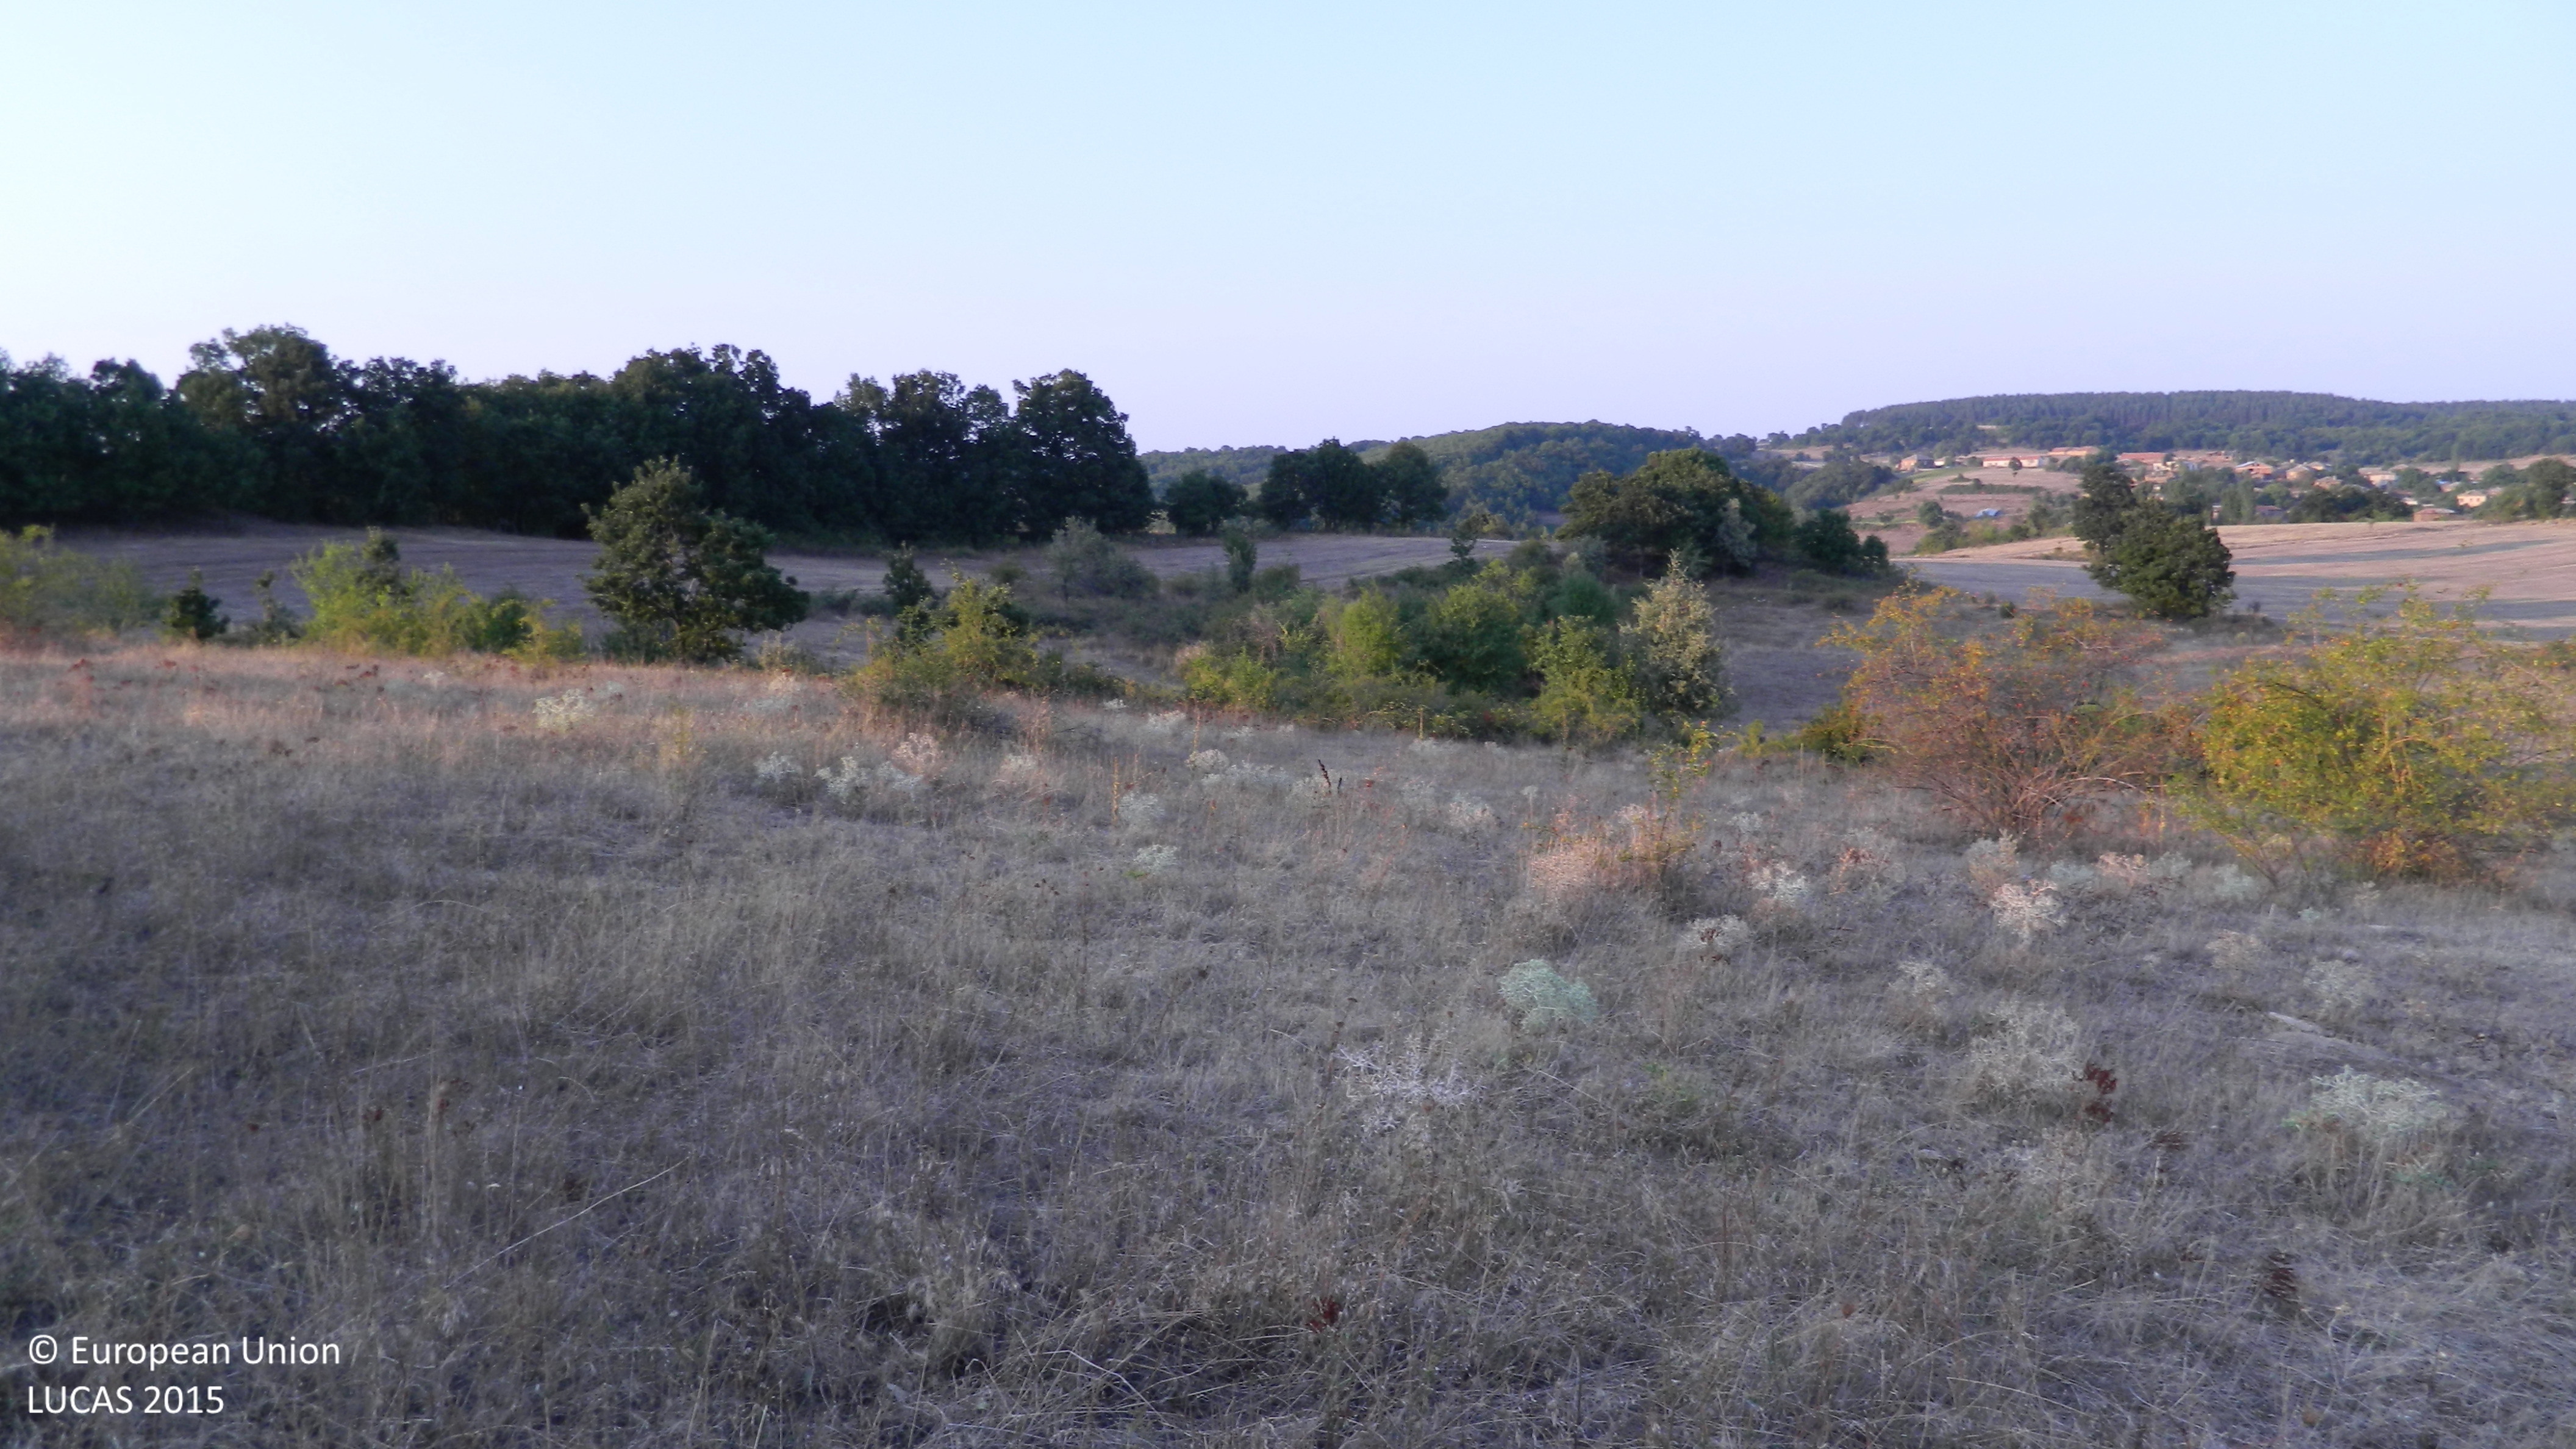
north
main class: Grassland
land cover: Grassland with sparse tree/shrub cover
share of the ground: > 75 %
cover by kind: herbaceous plants 90 %, broadleaved forest trees 5 %, shrubs 5 %
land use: Agriculture (excluding fallow land and kitchen gardens)
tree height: < 5 m
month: August
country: BG
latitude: 41.4967
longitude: 25.9139
